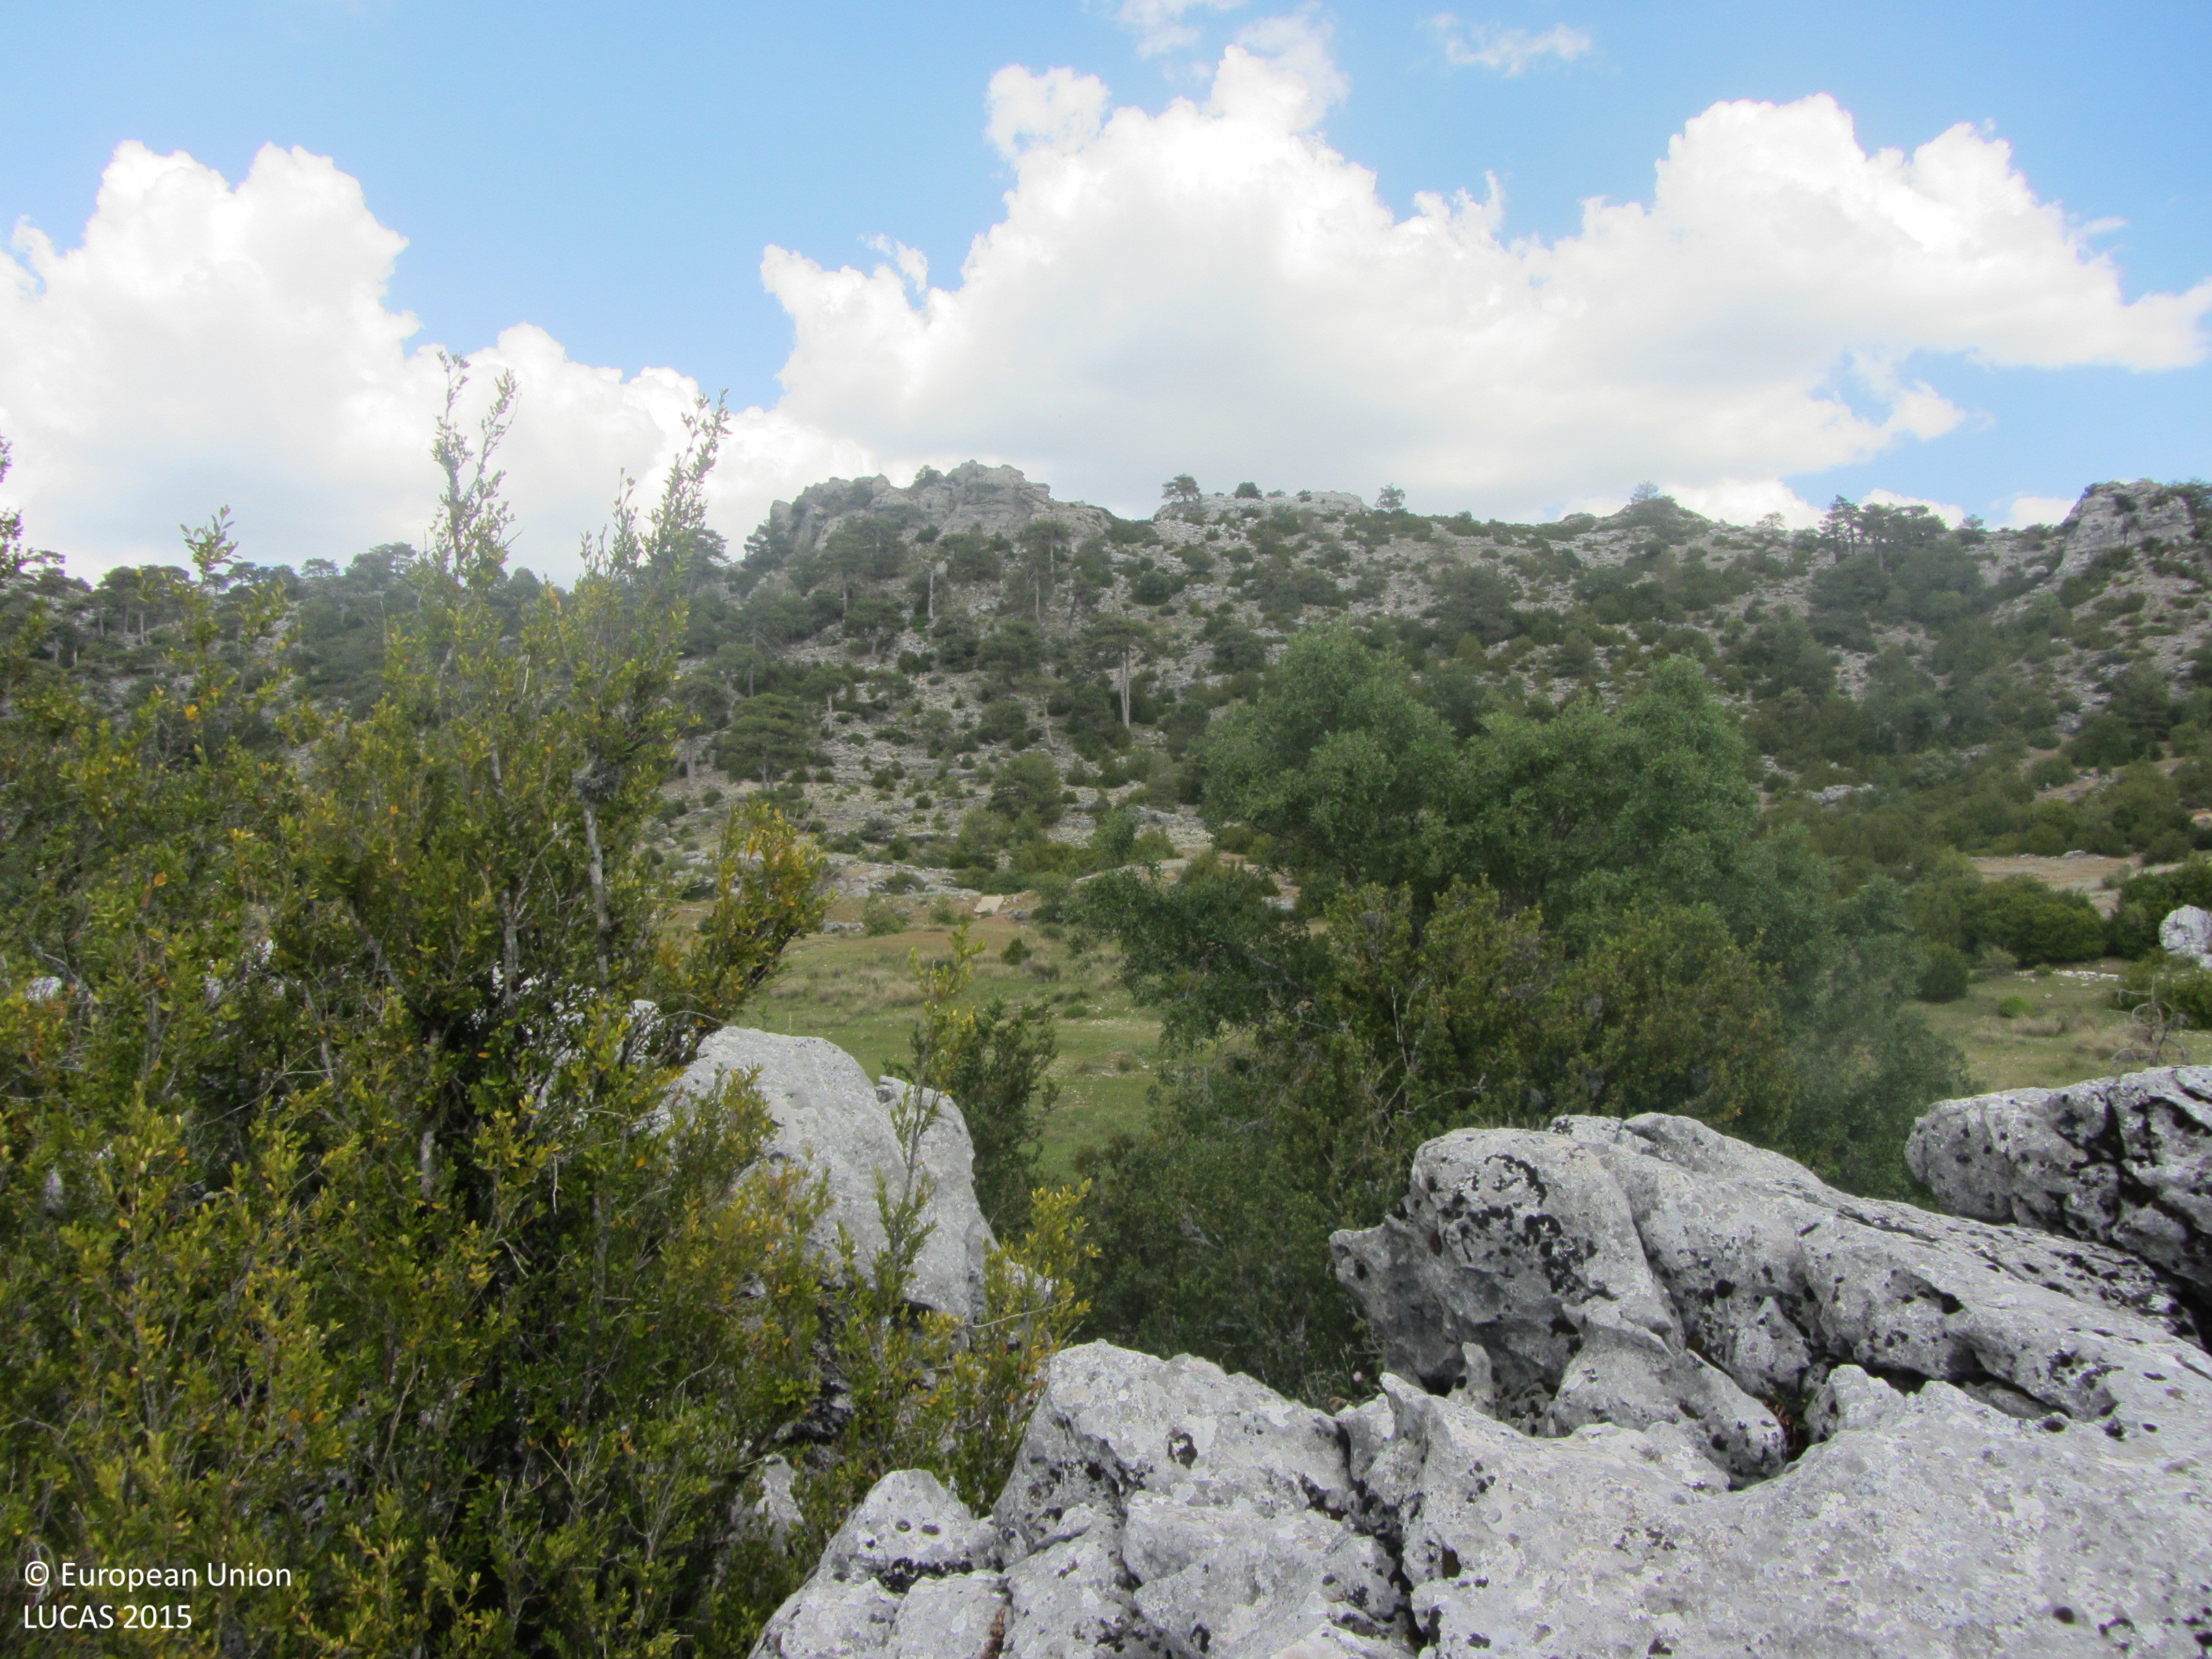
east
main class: Woodland
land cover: Pine dominated mixed woodland
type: coniferous forest of the mediterranean region
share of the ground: 50 - 75 %
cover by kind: consolidated bare surface 30 %, coniferous forest trees 25 %, broadleaved forest trees 25 %, shrubs 20 %
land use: Semi-natural and natural areas not in use
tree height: > 5 m
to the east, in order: Pine dominated mixed woodland; Shrubland with sparse tree cover; Ditches and canals; Grassland without tree/shrub cover; Other structural elements; Grassland without tree/shrub cover; Other structural elements; Shrubland with sparse tree cover; Tracks; Shrubland with sparse tree cover; Pine dominated coniferous woodland
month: May
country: ES
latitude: 38.0555
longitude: -2.9087
